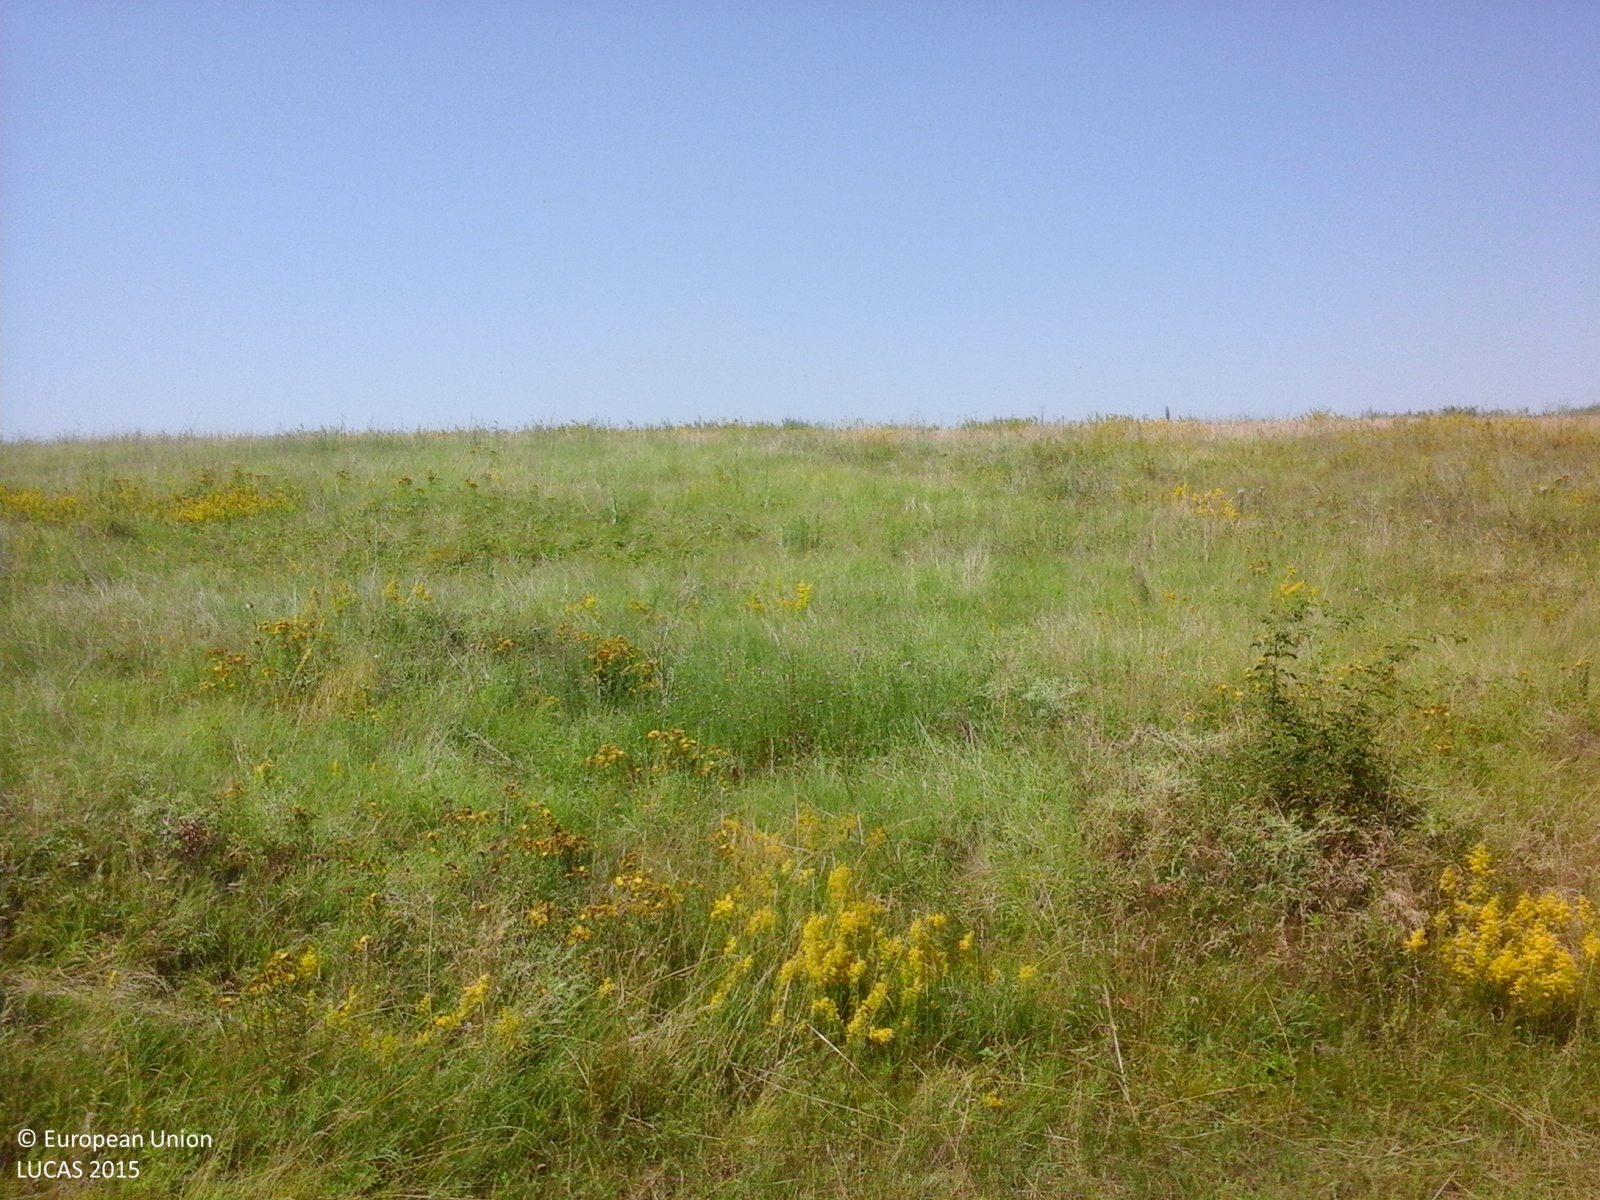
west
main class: Grassland
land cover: Spontaneously vegetated surfaces
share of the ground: > 75 %
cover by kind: herbaceous plants 100 %
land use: Fallow land
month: July
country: RO
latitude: 44.4058
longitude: 24.4979
